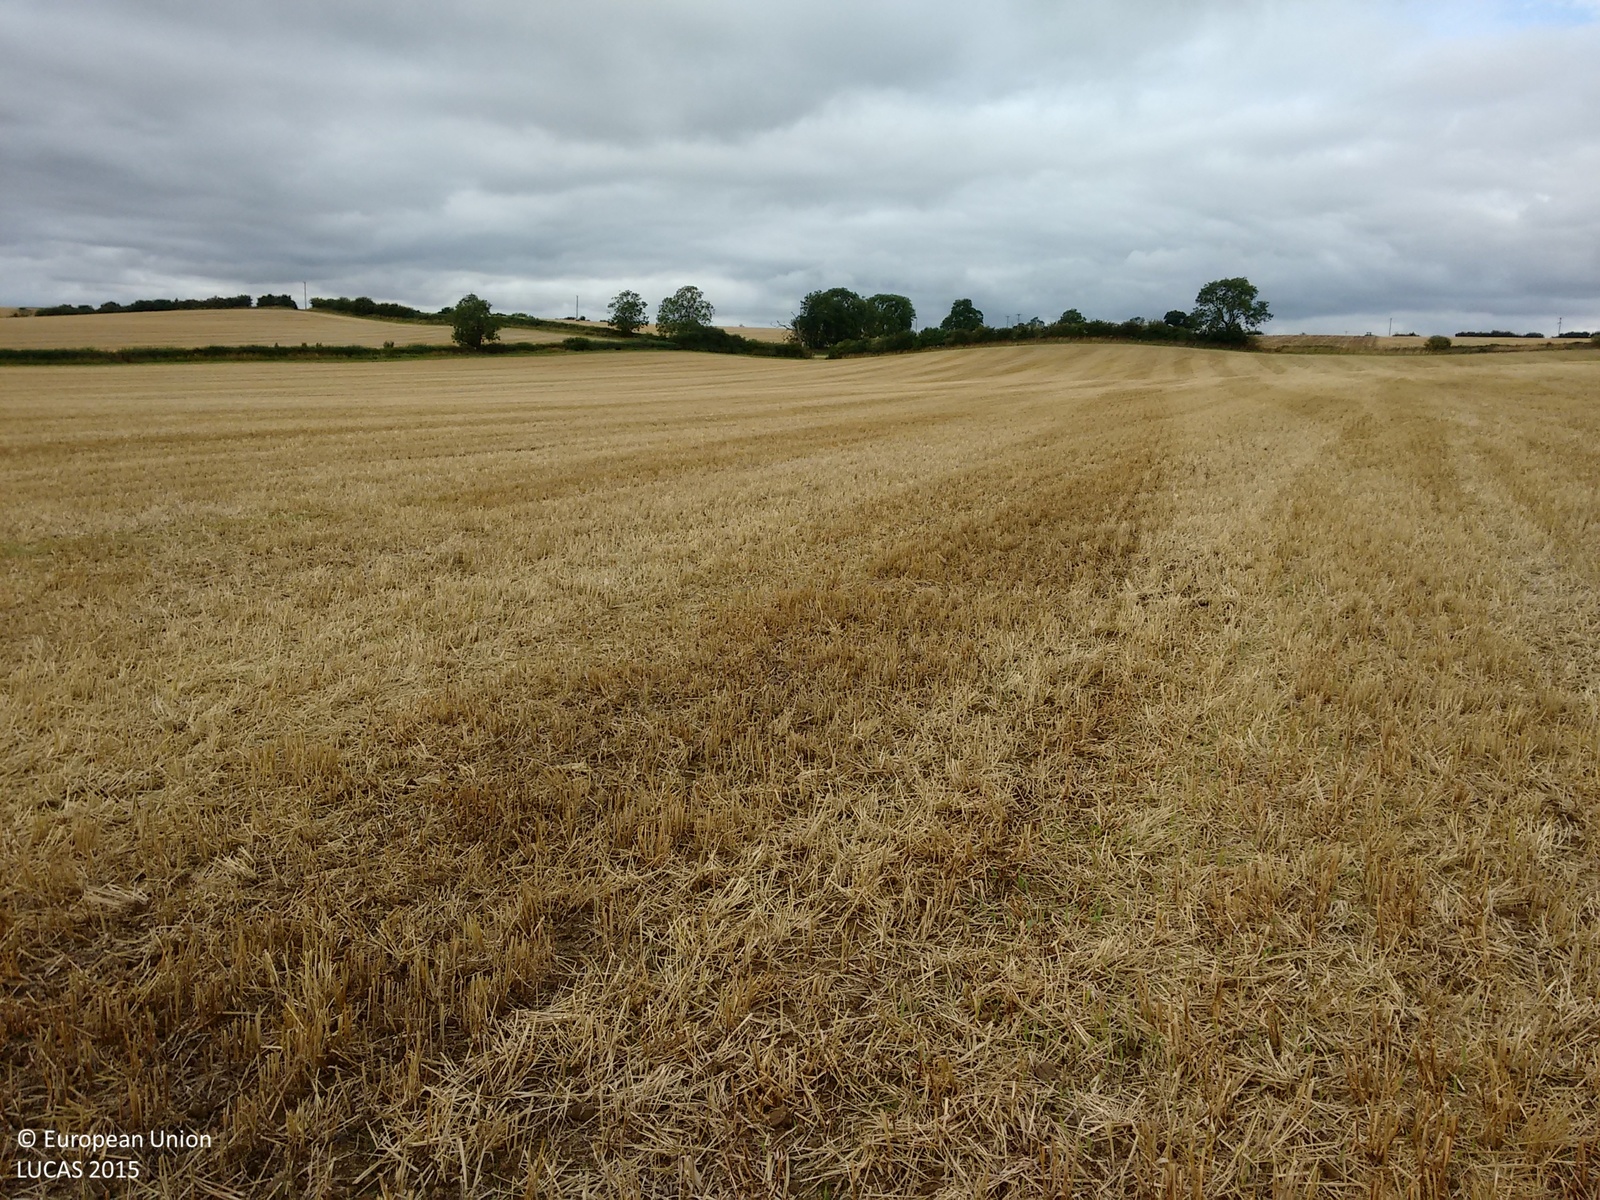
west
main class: Cropland
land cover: Common wheat
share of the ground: 10 - 25 %
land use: Agriculture (excluding fallow land and kitchen gardens)
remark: Harvested field
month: August
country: GB
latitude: 52.3670
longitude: -0.8665
